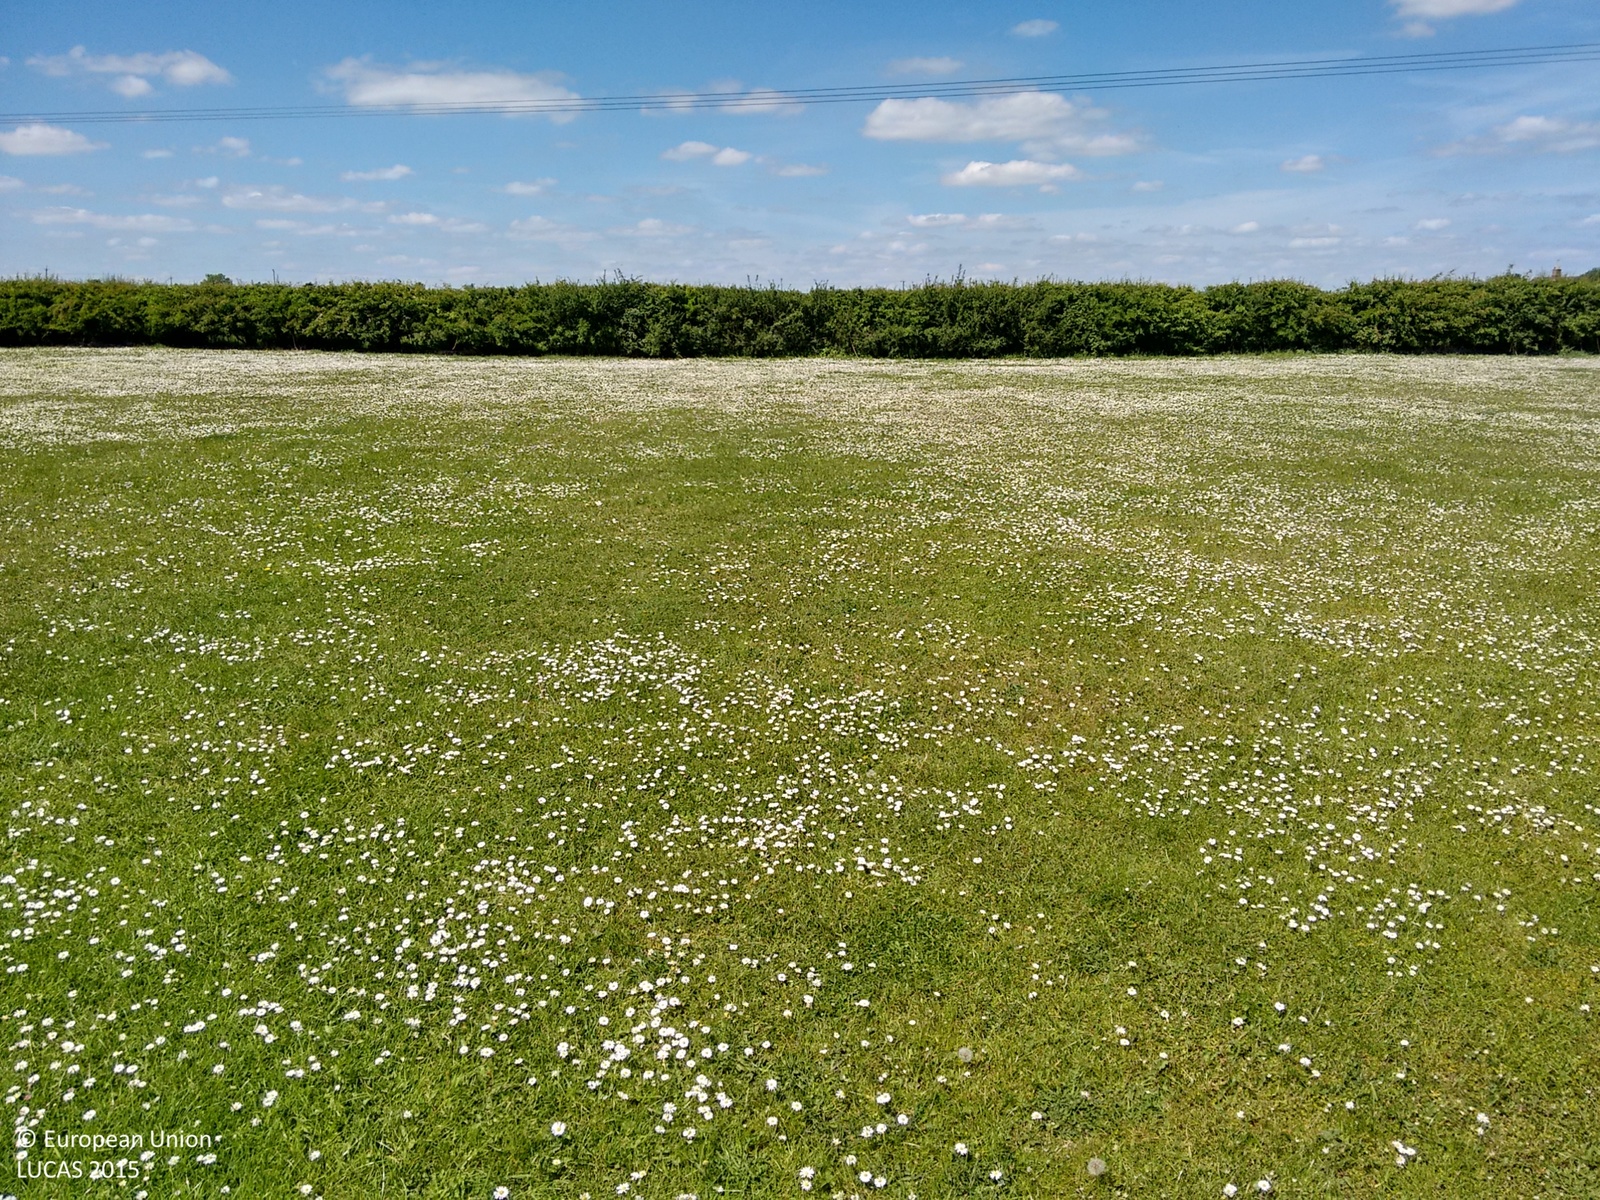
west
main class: Grassland
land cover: Grassland without tree/shrub cover
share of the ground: > 75 %
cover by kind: herbaceous plants 100 %
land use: Sport
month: June
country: GB
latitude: 52.6601
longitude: -0.4308
